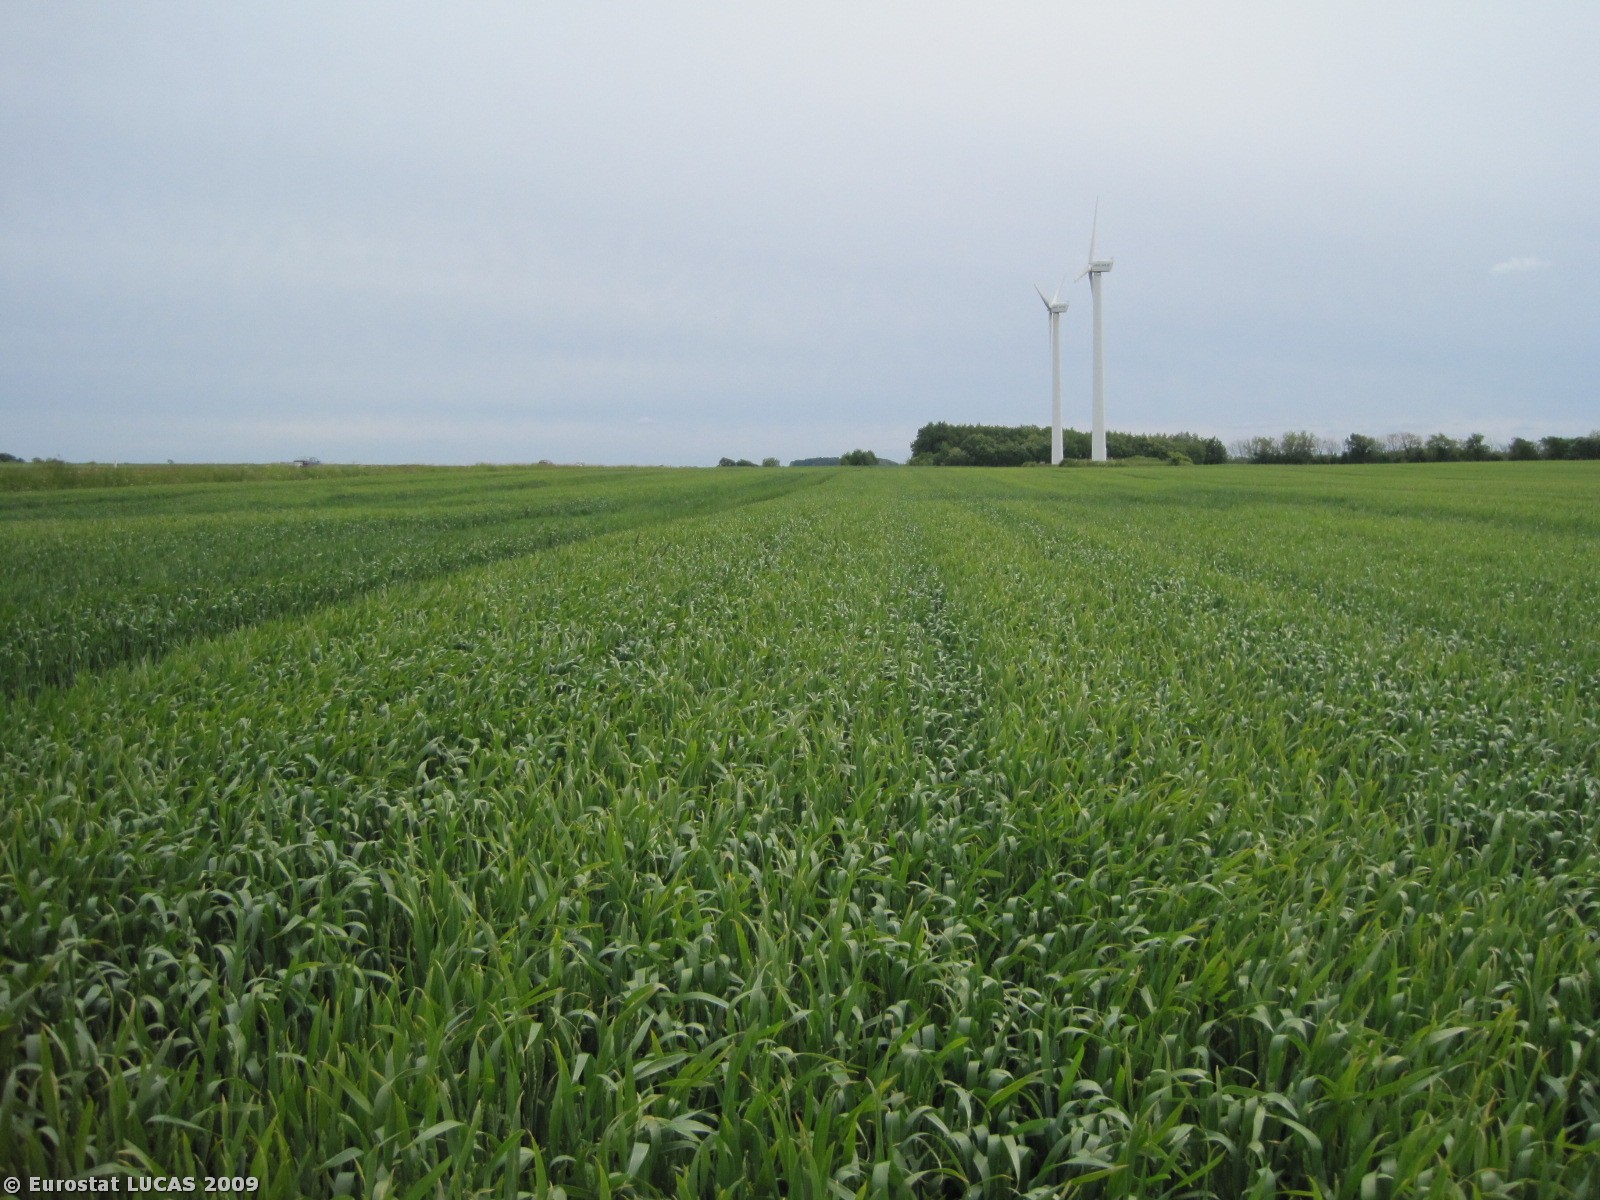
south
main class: Cropland
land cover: Common wheat
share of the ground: > 75 %
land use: Agriculture (excluding fallow land and kitchen gardens)
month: June
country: DK
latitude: 57.3743
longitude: 9.9834
